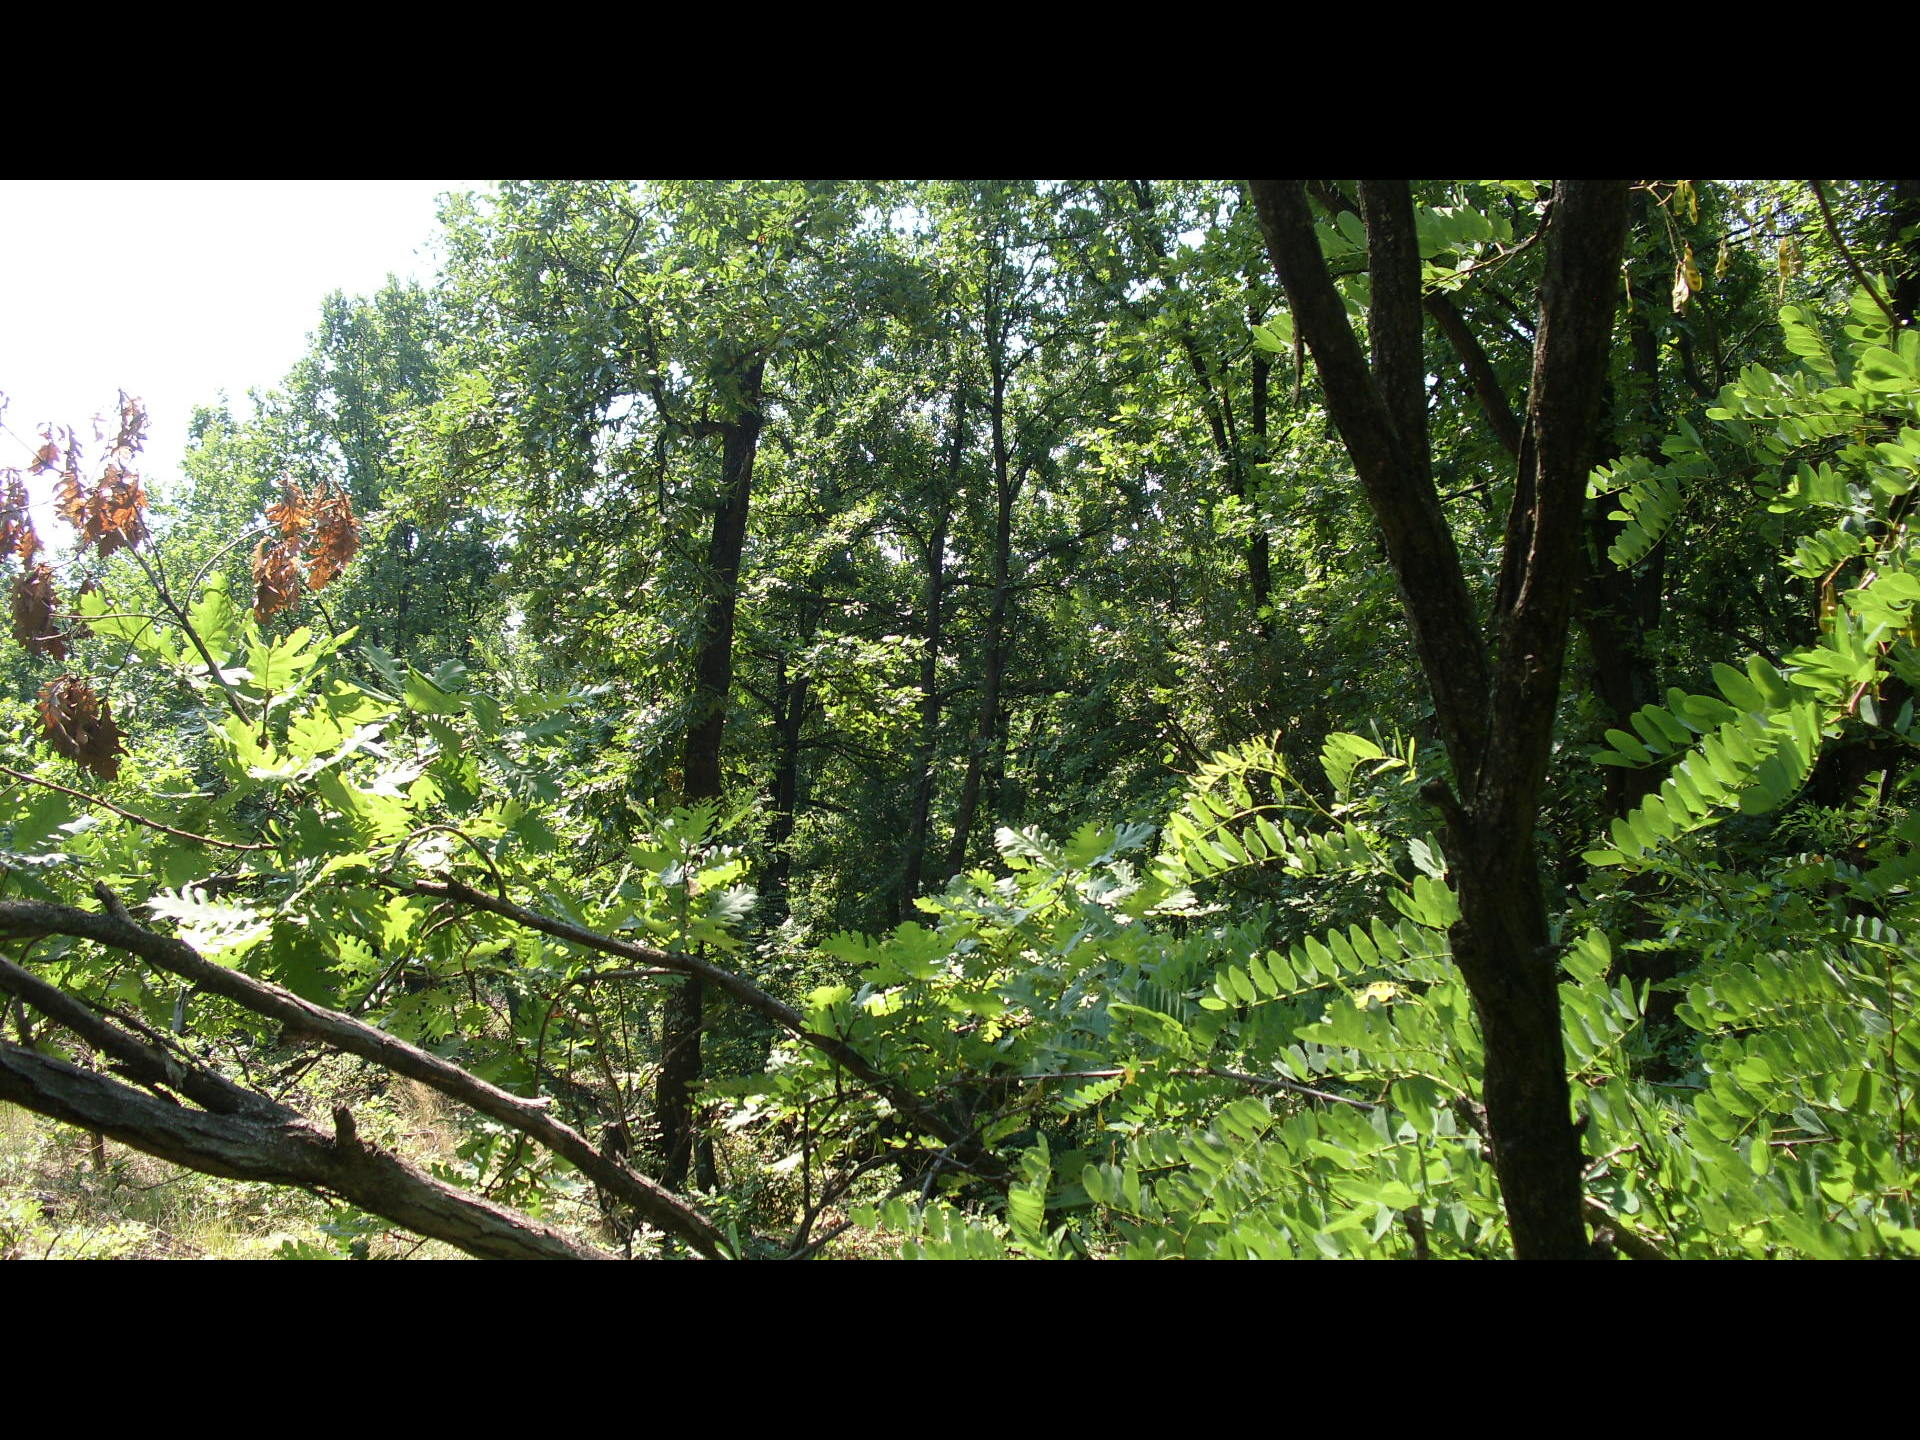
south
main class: Woodland
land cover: Broadleaved woodland
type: mesophytic deciduous forest
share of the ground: > 75 %
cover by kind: broadleaved forest trees 100 %
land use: Forestry
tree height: > 5 m
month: July
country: BG
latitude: 43.7950
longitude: 22.6242
